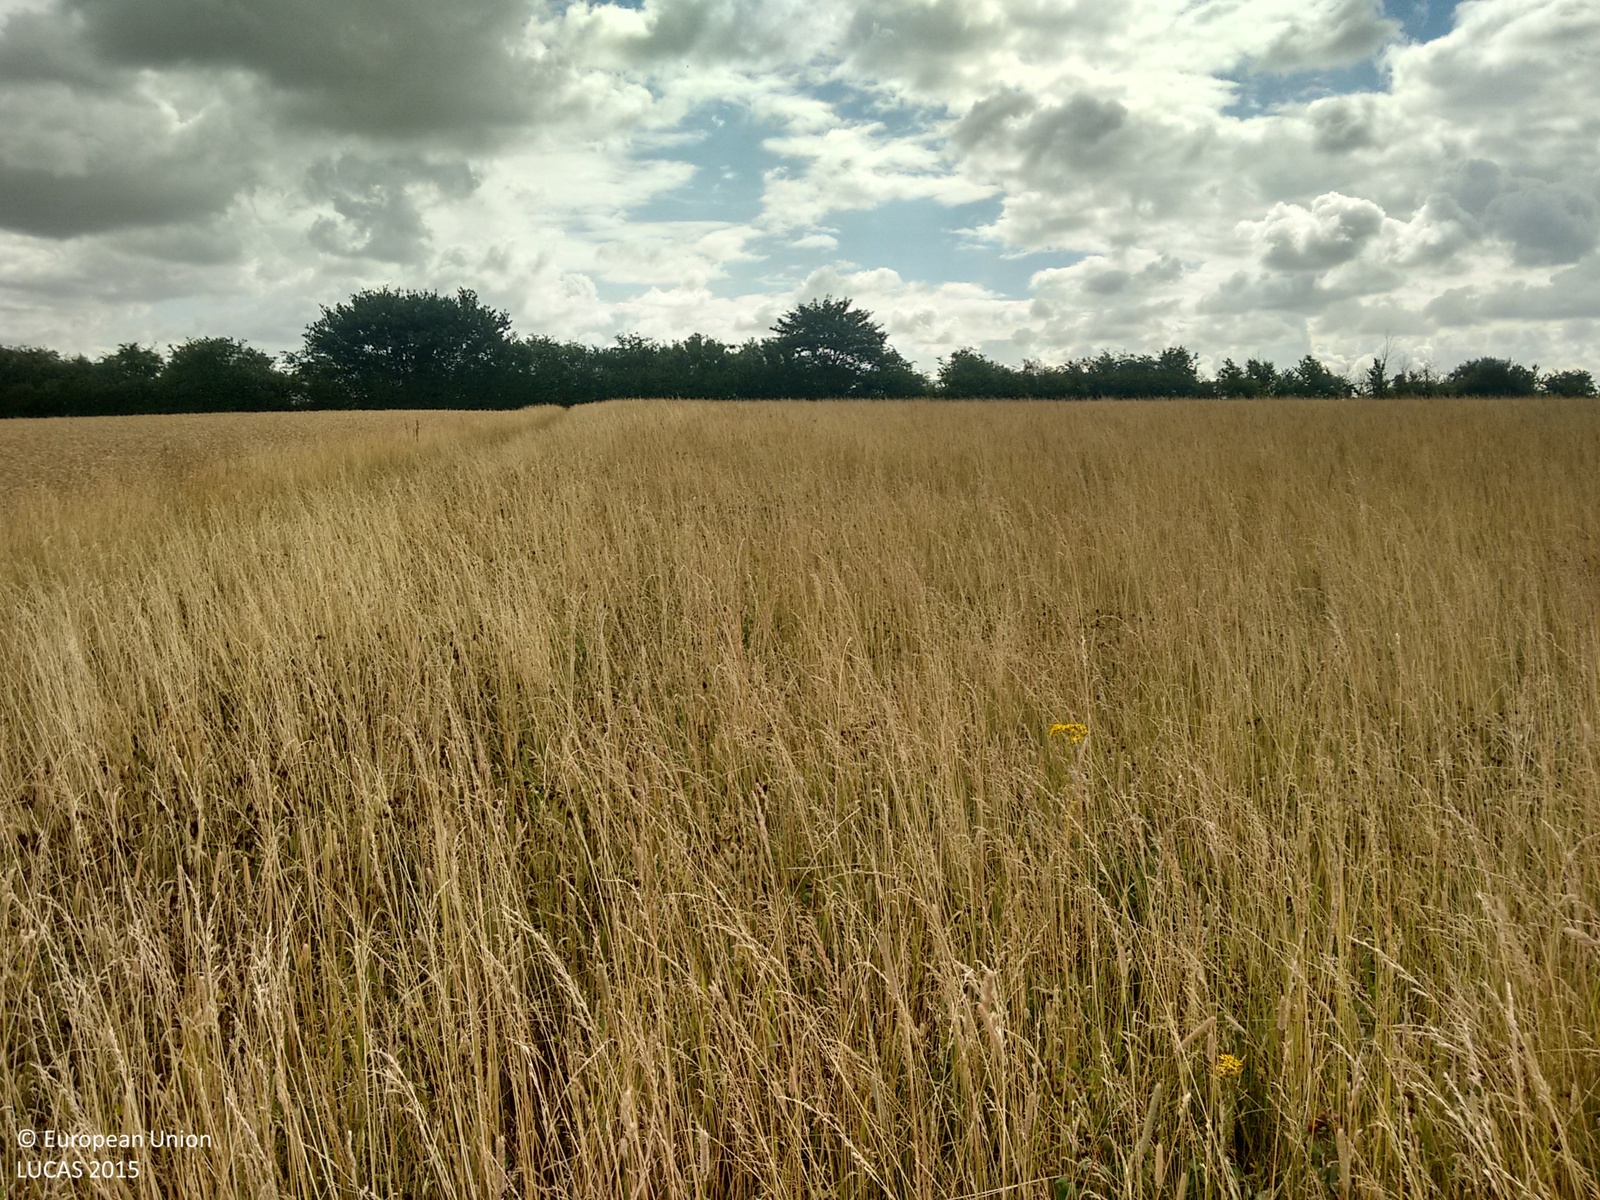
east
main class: Grassland
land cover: Grassland without tree/shrub cover
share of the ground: > 75 %
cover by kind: herbaceous plants 100 %
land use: Agriculture (excluding fallow land and kitchen gardens)
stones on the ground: 10 - 25 %
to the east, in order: Grassland without tree/shrub cover; Managed hedges; Ditches and canals; Grass margins; Dry pulses
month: July
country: GB
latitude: 51.8441
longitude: 0.6401
